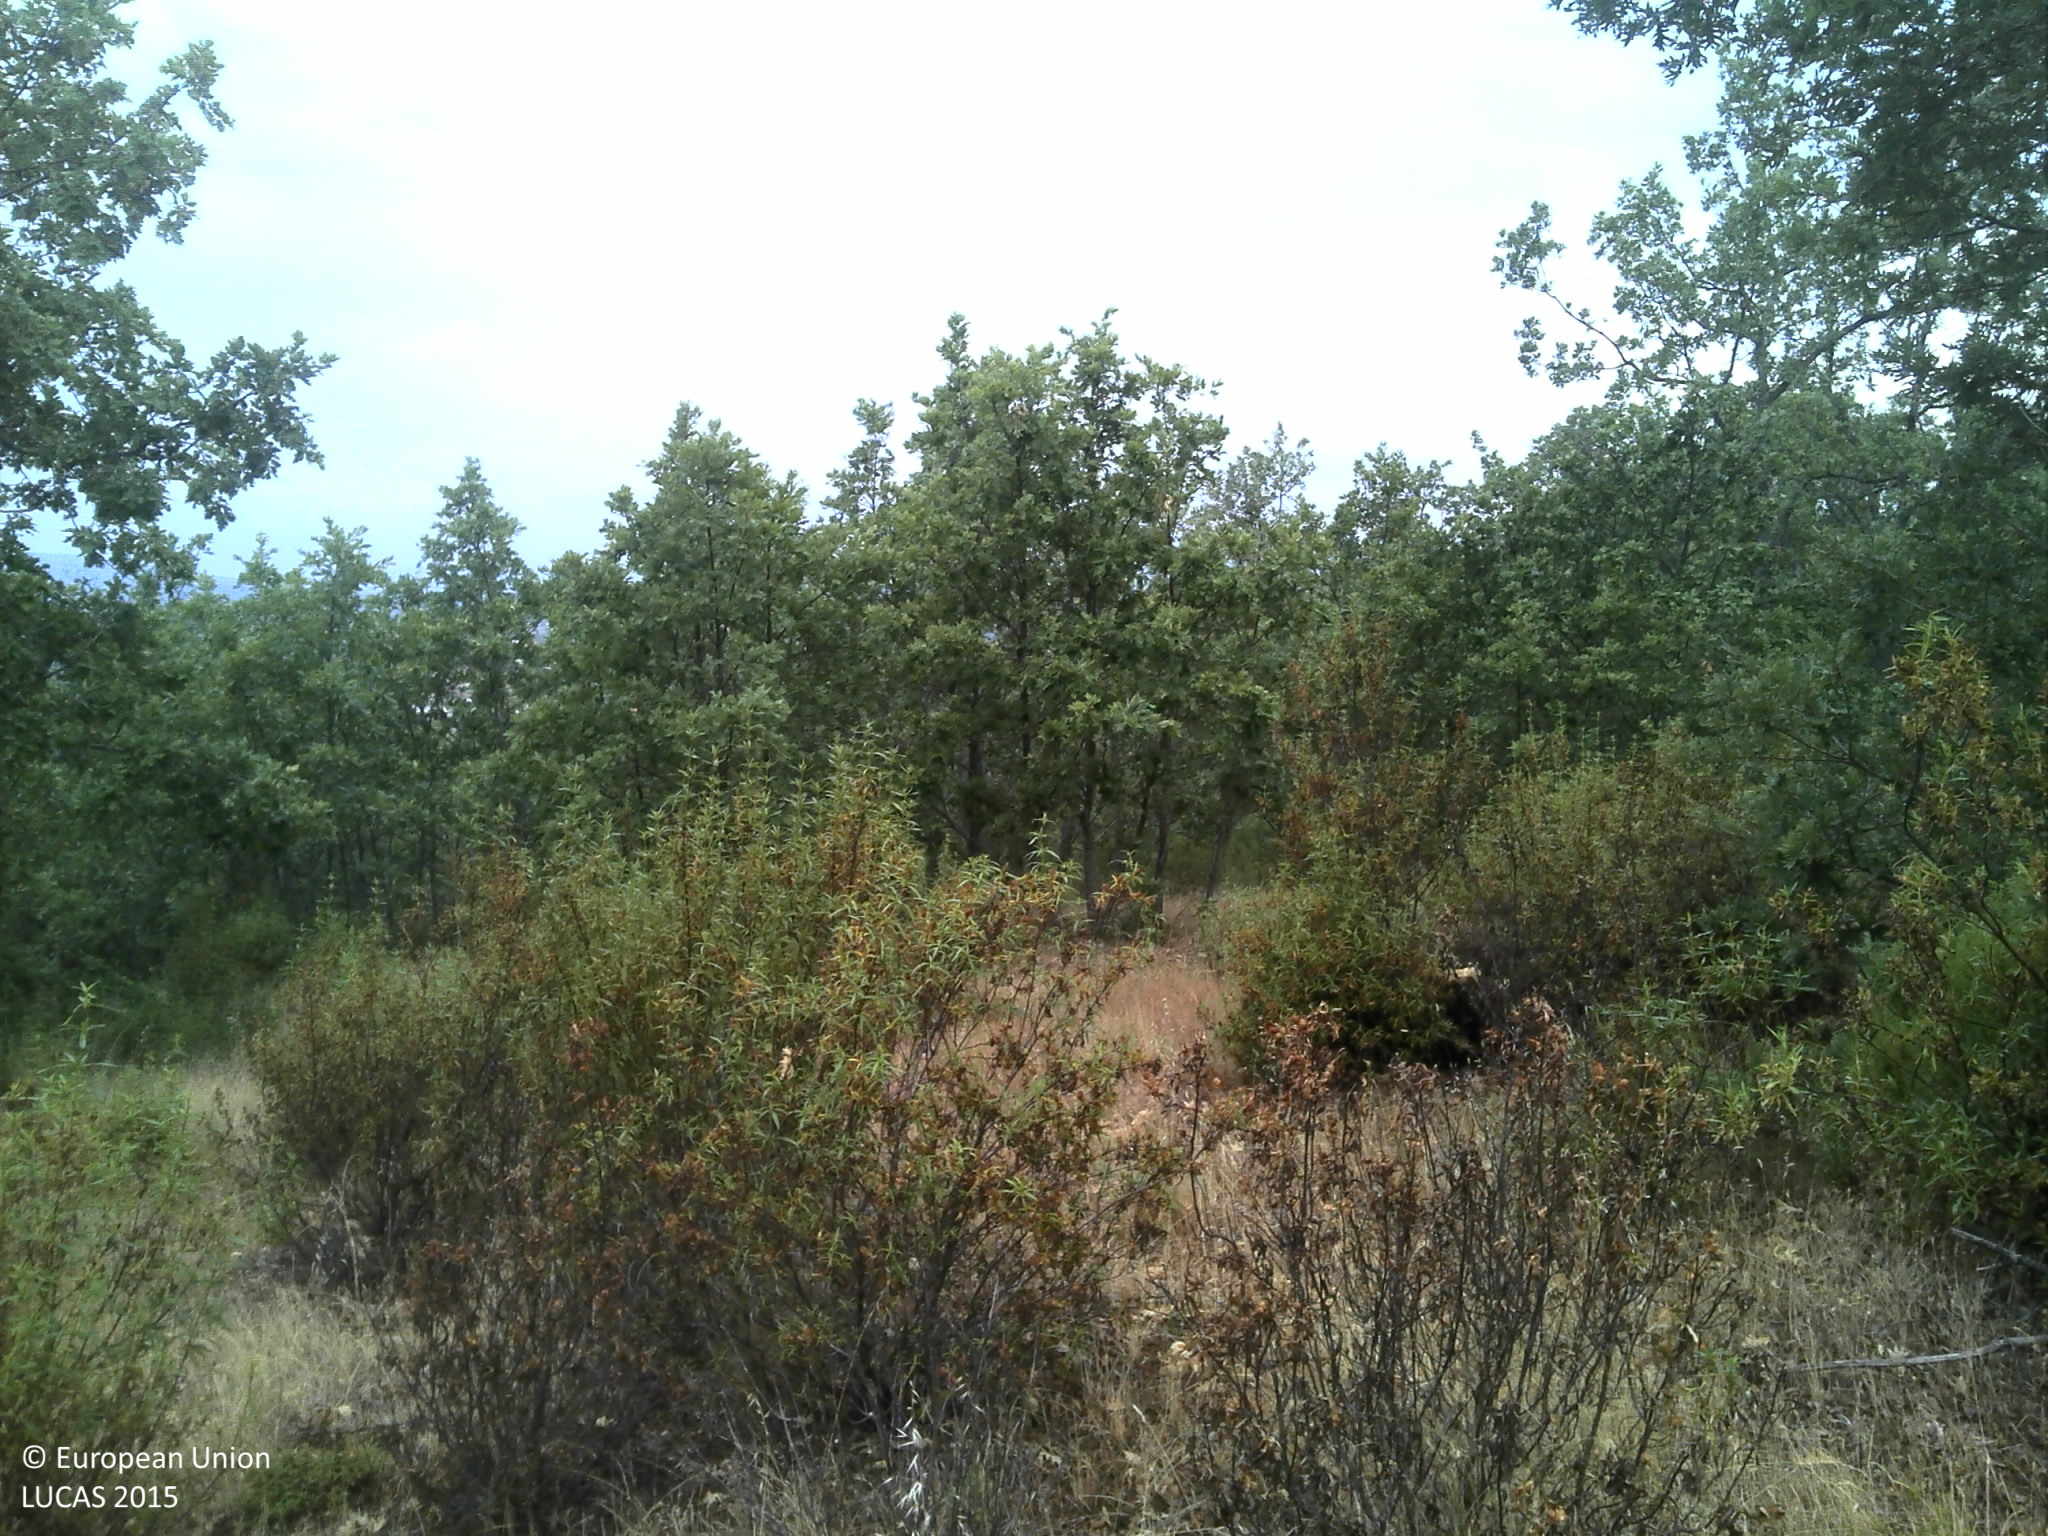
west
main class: Woodland
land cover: Broadleaved woodland
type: acidophilous oak and oak-birch forest
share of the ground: 25 - 50 %
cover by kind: broadleaved forest trees 35 %, herbaceous plants 30 %, unconsolidated bare surface 20 %, shrubs 15 %
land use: Forestry
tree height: > 5 m
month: June
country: PT
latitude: 40.1979
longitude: -7.4795
